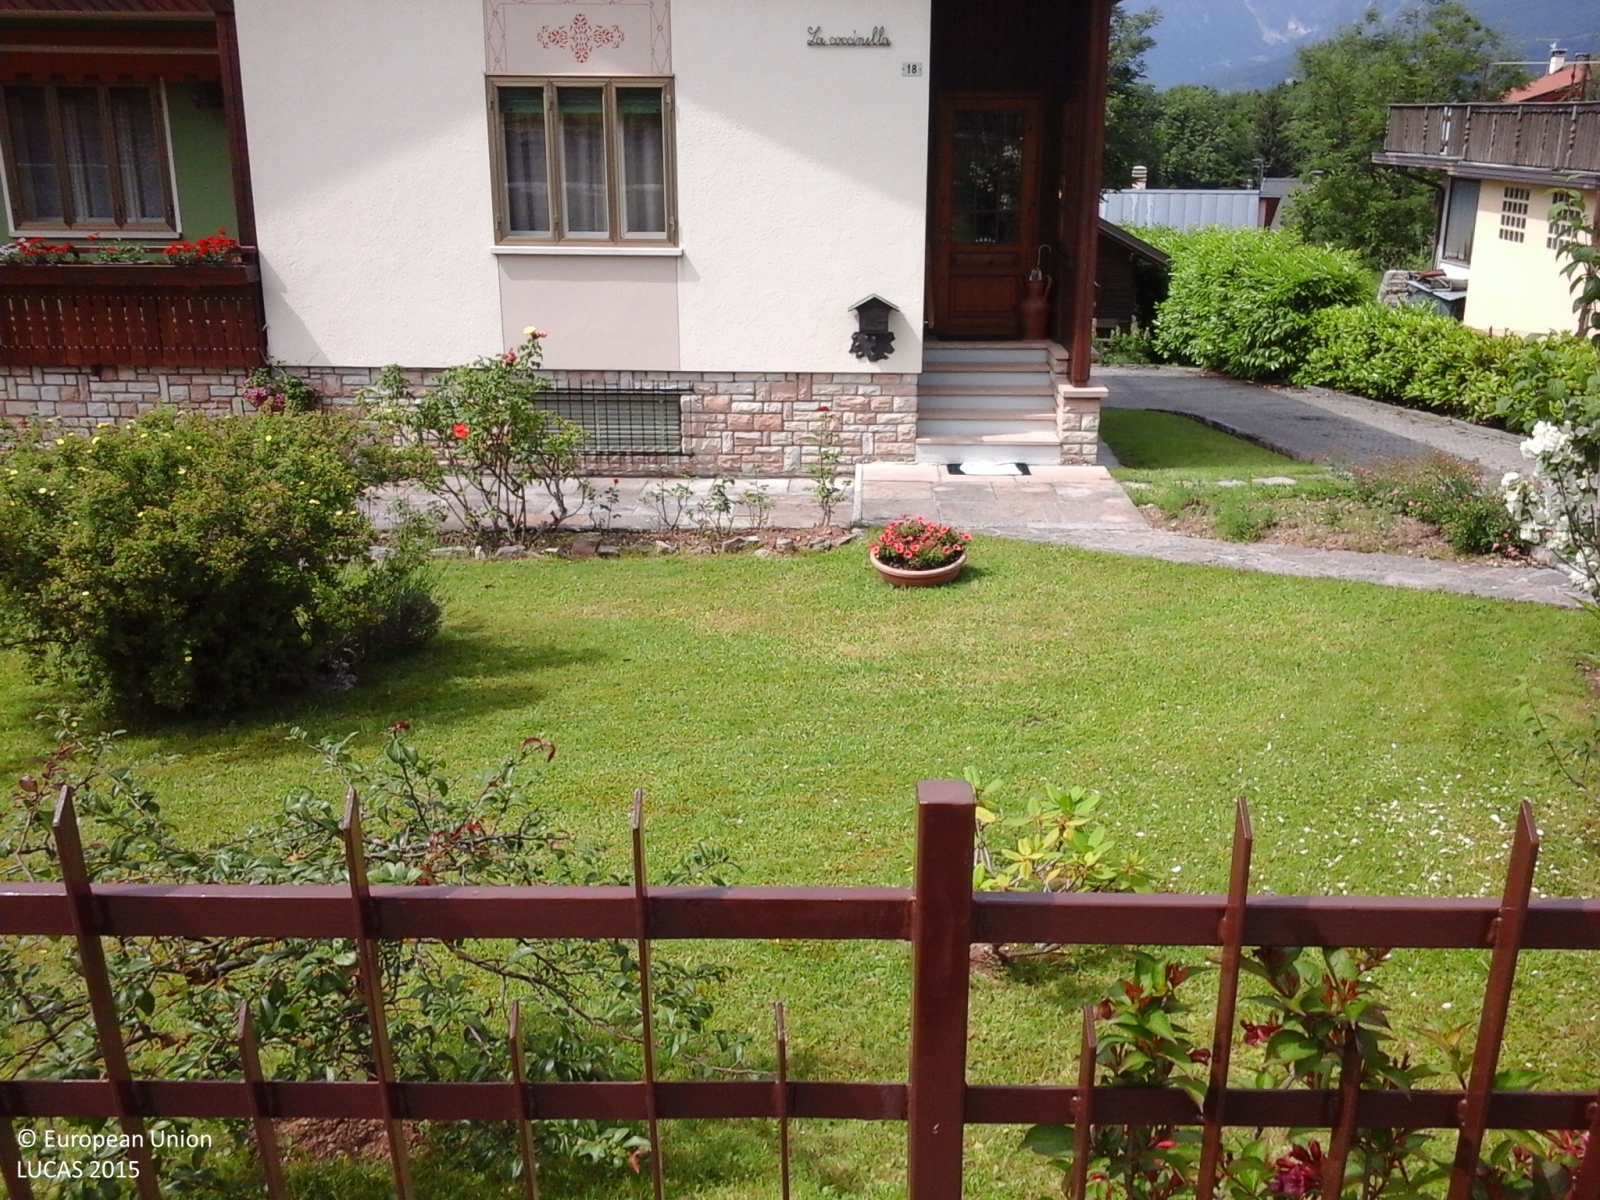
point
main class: Grassland
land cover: Grassland with sparse tree/shrub cover
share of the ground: > 75 %
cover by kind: herbaceous plants 95 %, broadleaved forest trees 5 %
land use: Residential
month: June
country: IT
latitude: 46.1257
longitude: 12.4171
